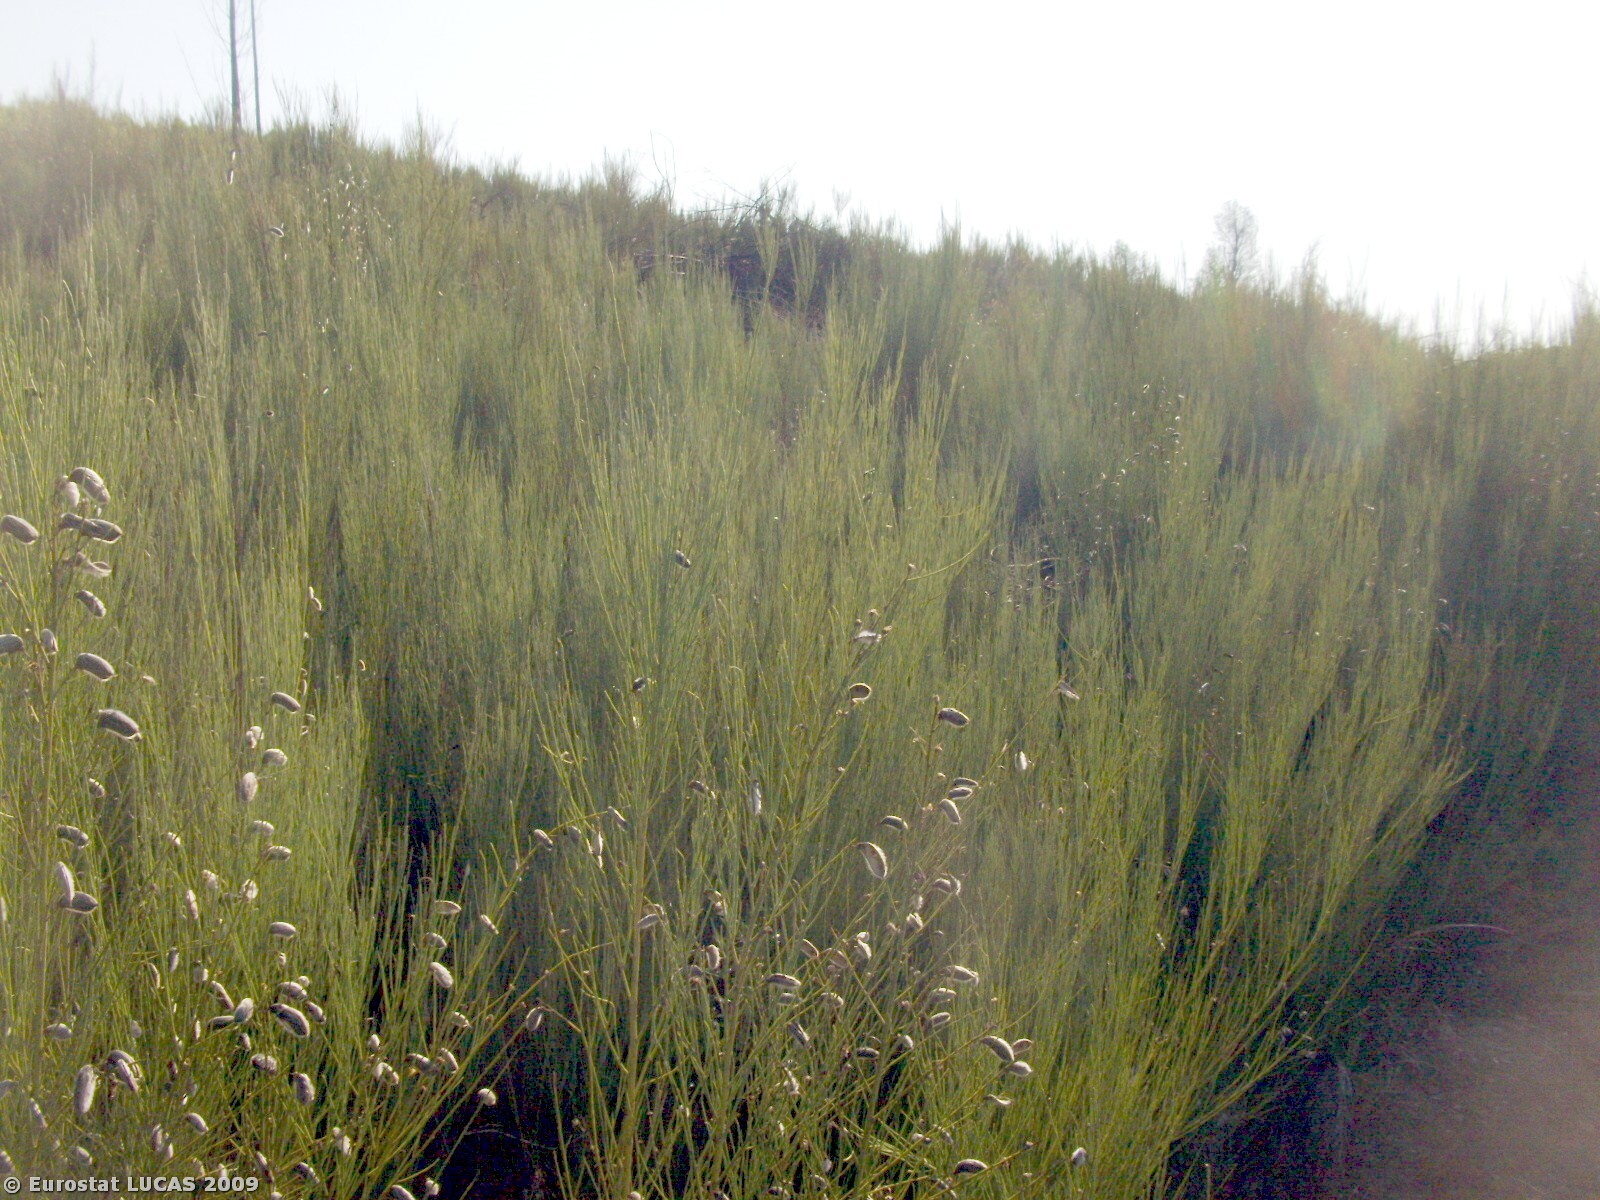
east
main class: Shrubland
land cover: Shrubland with sparse tree cover
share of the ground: > 75 %
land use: Forestry
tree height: > 5 m
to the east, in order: Shrubland with sparse tree cover
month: August
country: PT
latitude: 40.1603
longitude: -7.6857
